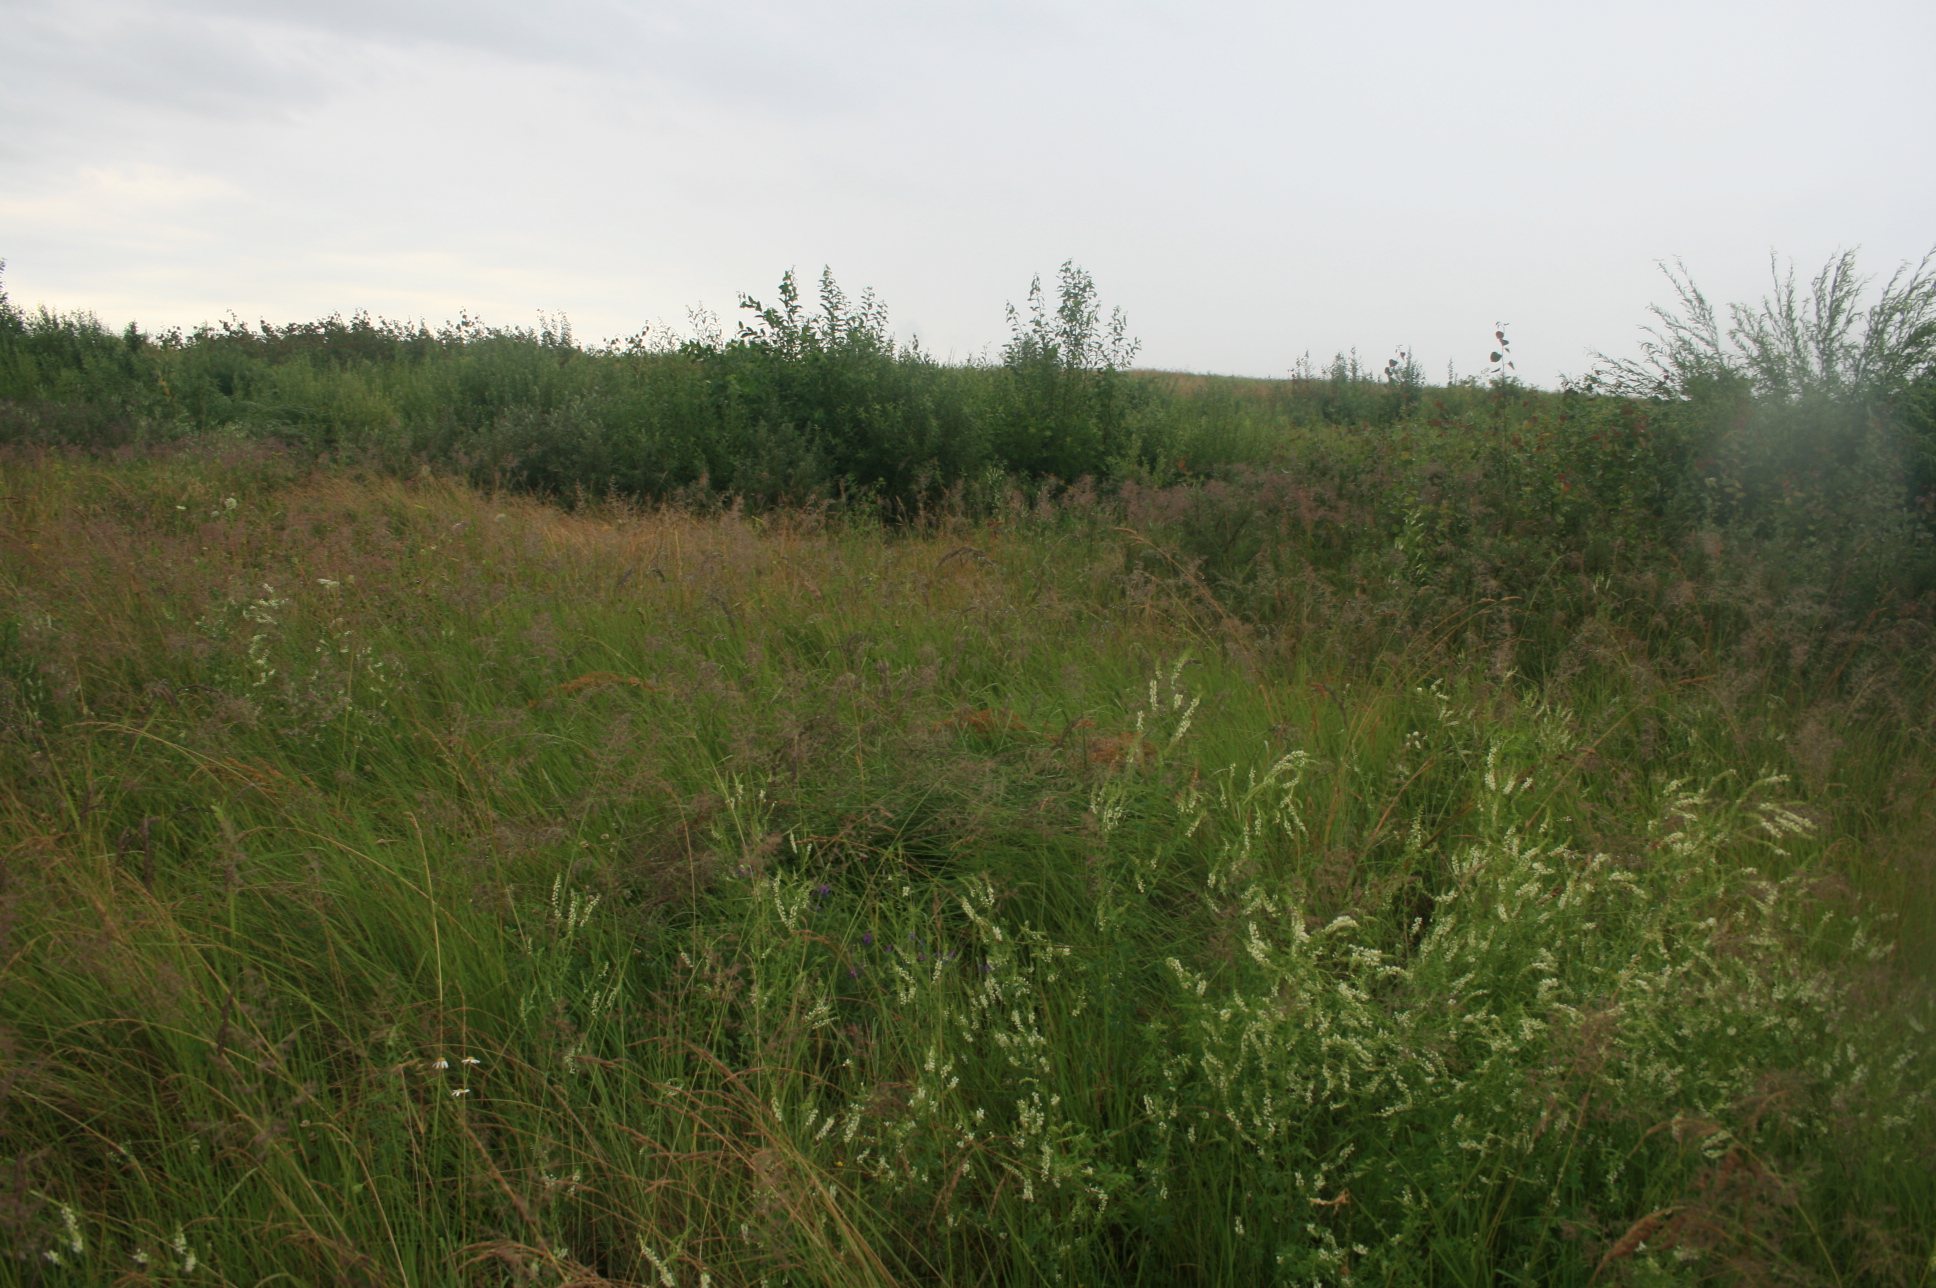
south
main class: Grassland
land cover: Grassland with sparse tree/shrub cover
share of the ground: > 75 %
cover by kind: herbaceous plants 90 %, broadleaved forest trees 5 %, shrubs 5 %
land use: Semi-natural and natural areas not in use
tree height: < 5 m
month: July
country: LT
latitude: 55.6581
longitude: 21.2153
